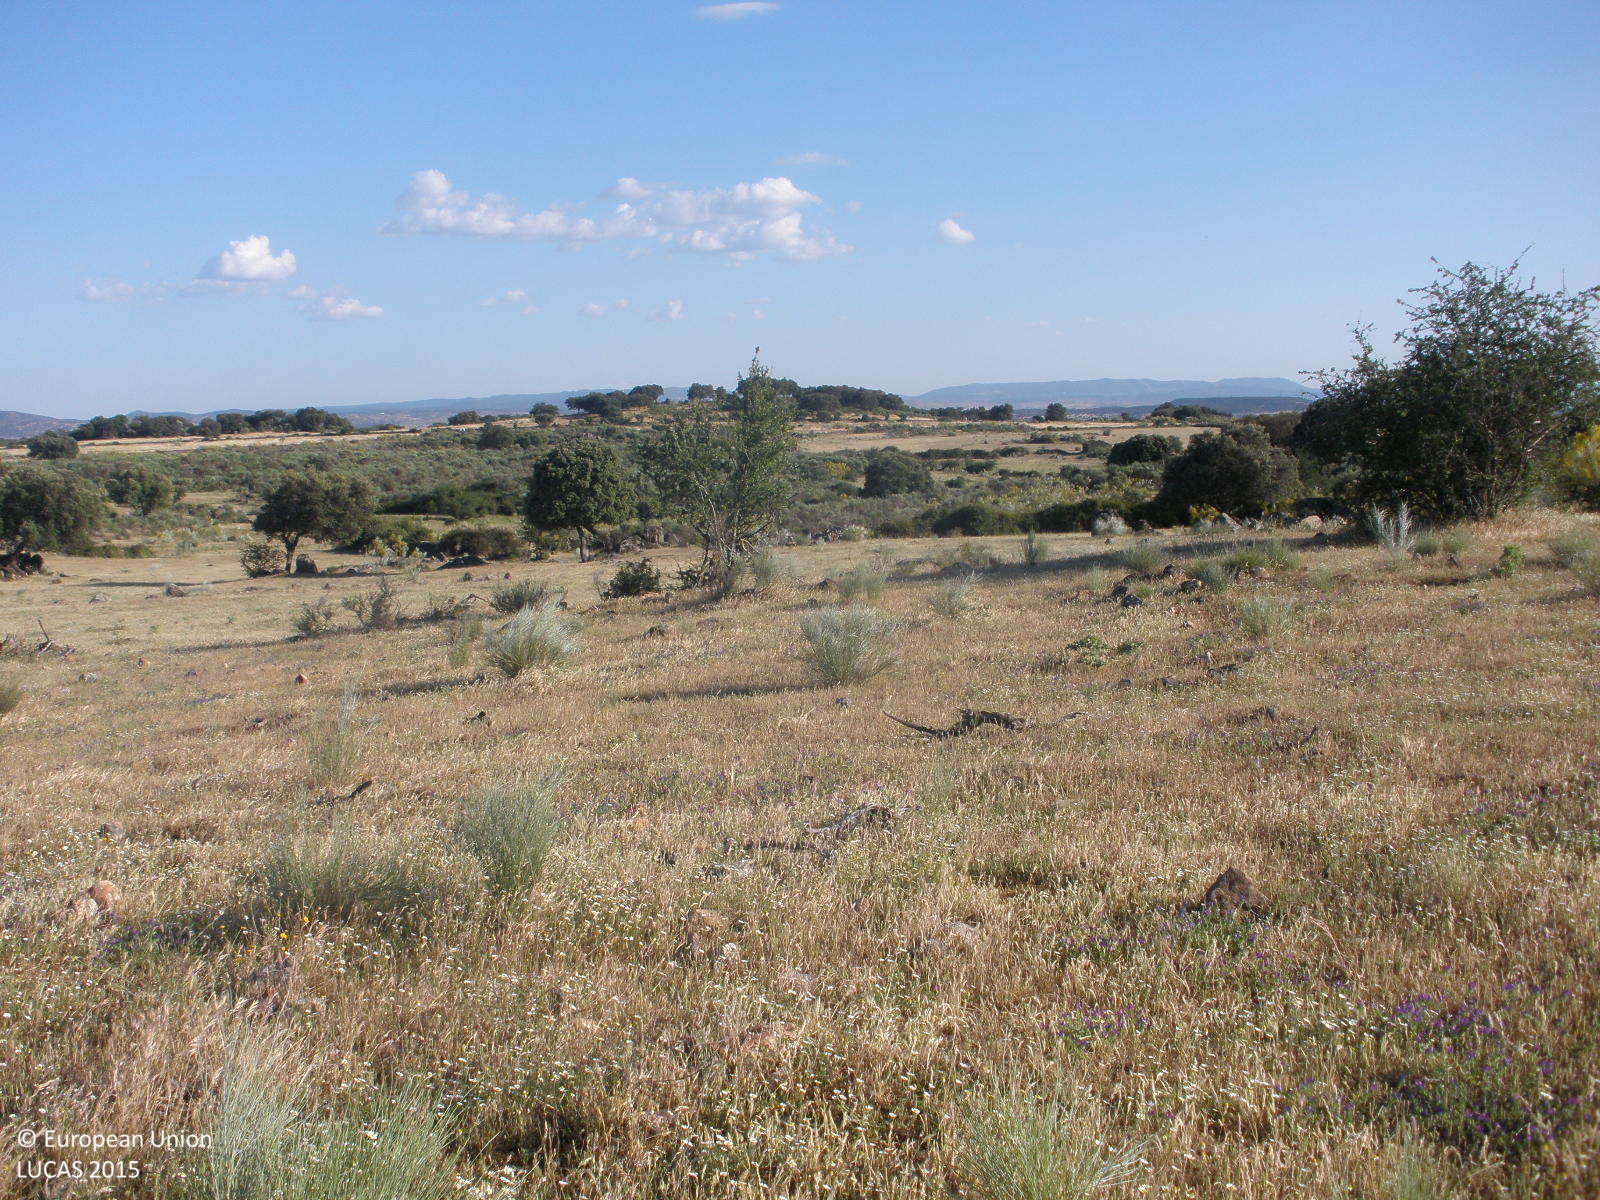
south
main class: Grassland
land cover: Grassland without tree/shrub cover
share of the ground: > 75 %
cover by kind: herbaceous plants 100 %
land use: Agriculture (excluding fallow land and kitchen gardens)
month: May
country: ES
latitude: 40.1026
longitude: -6.2288
